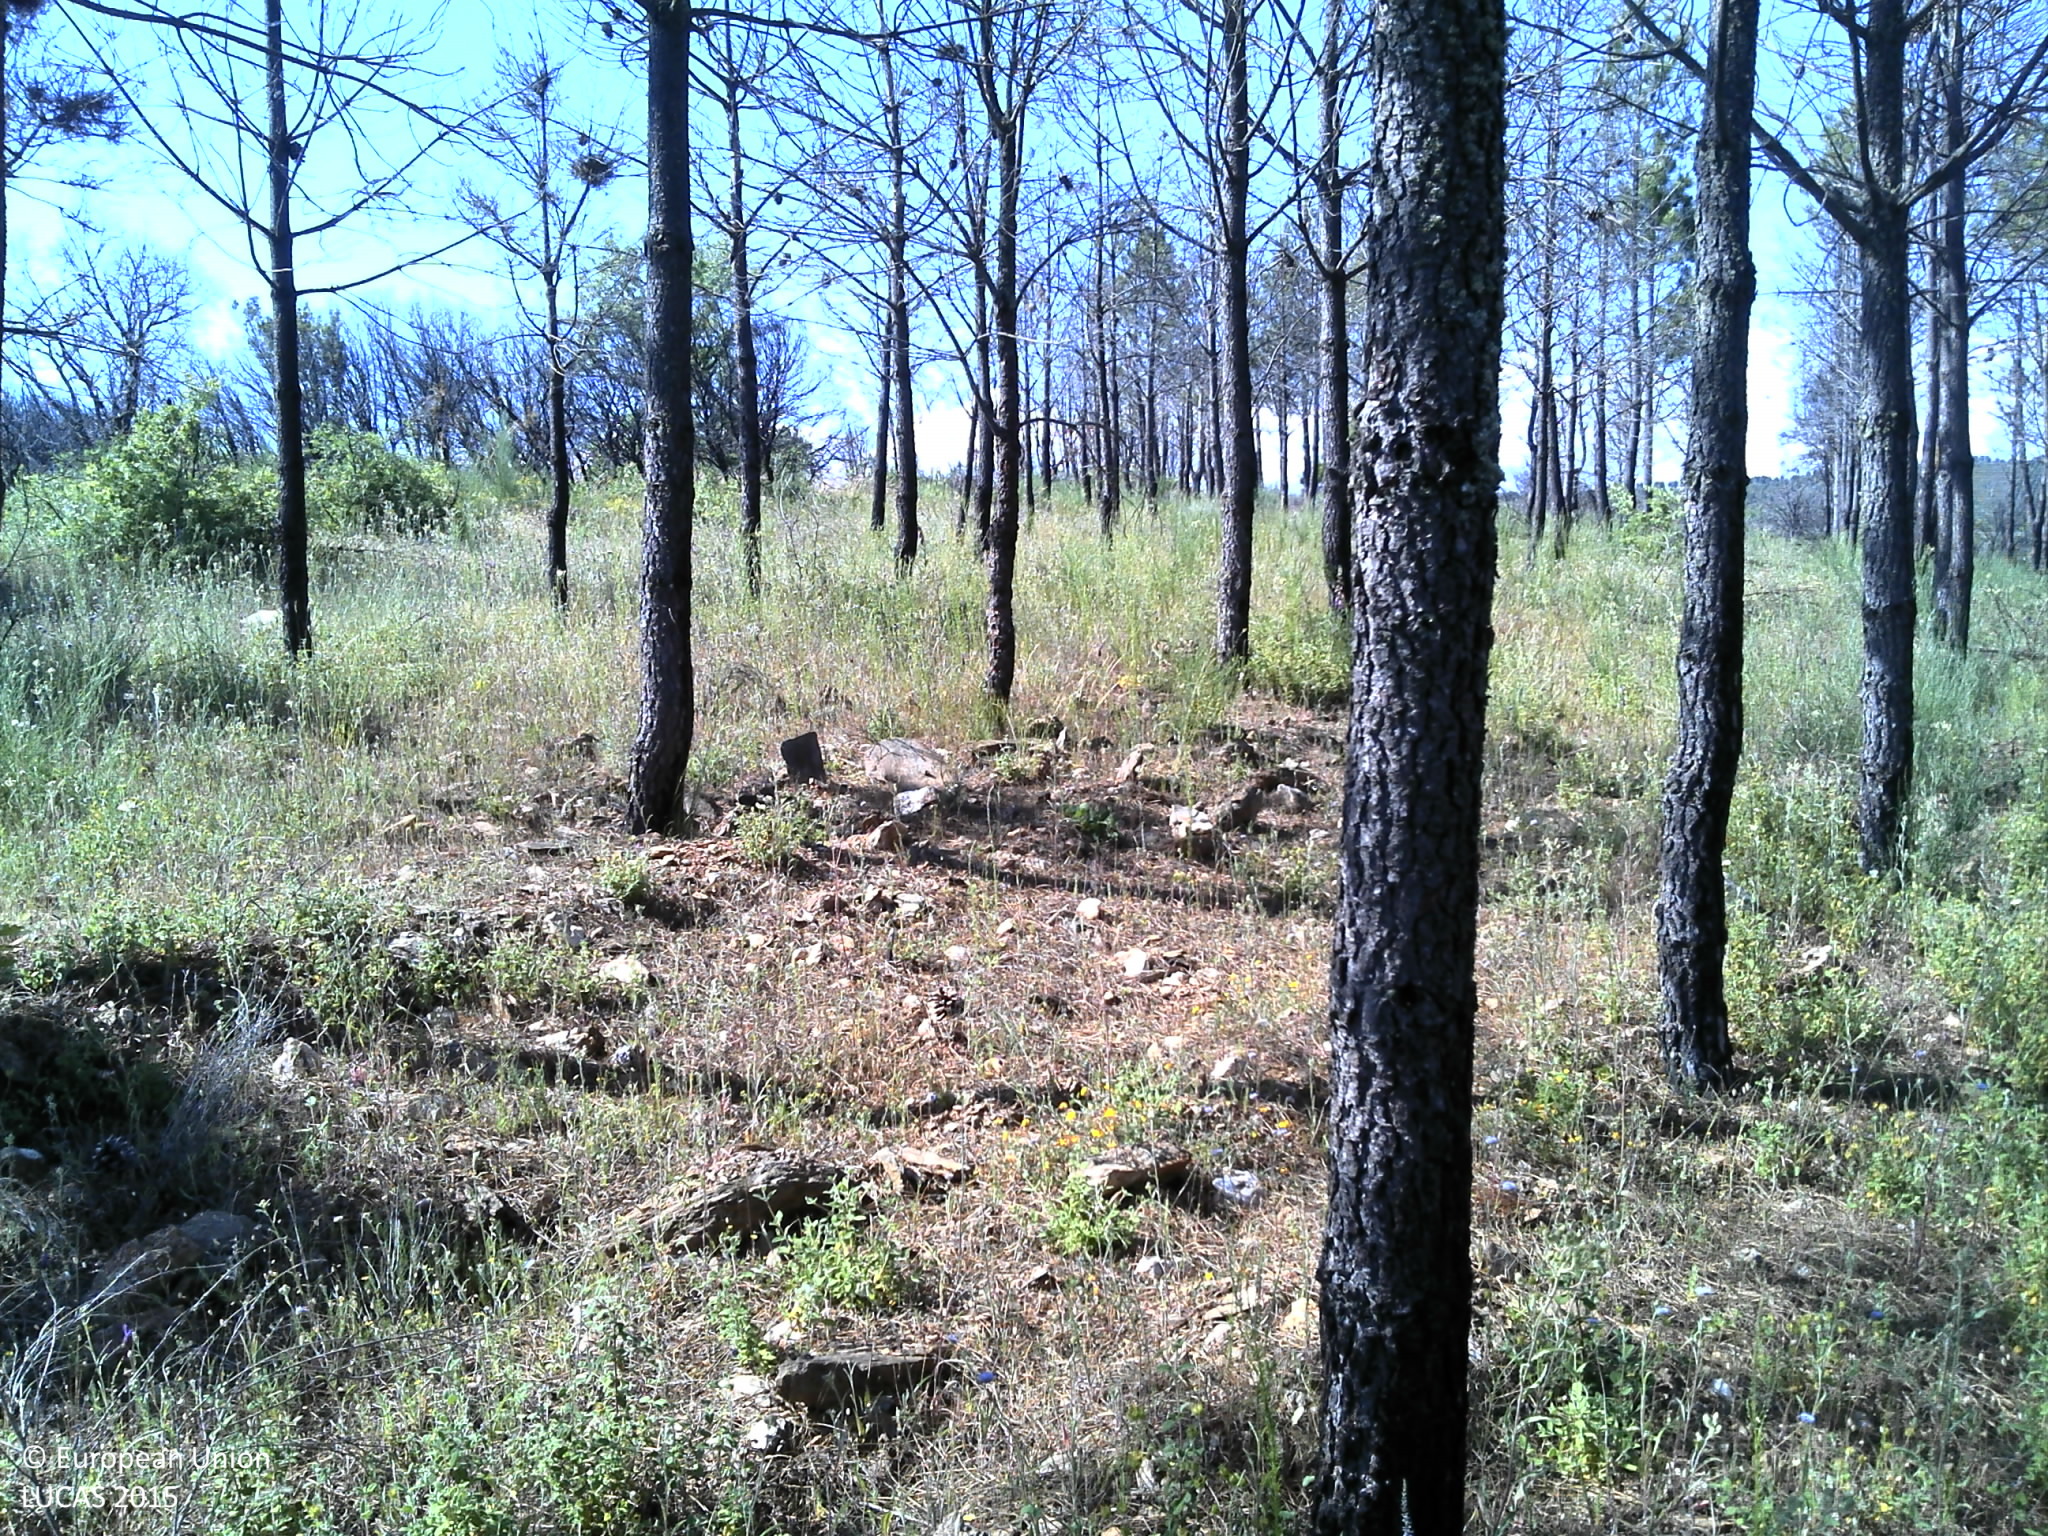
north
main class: Woodland
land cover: Pine dominated coniferous woodland
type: coniferous forest of the mediterranean region
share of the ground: 10 - 25 %
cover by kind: shrubs 50 %, unconsolidated bare surface 30 %, coniferous forest trees 20 %
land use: Forestry
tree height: > 5 m
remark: Burnt area
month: May
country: PT
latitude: 41.6505
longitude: -6.3227
